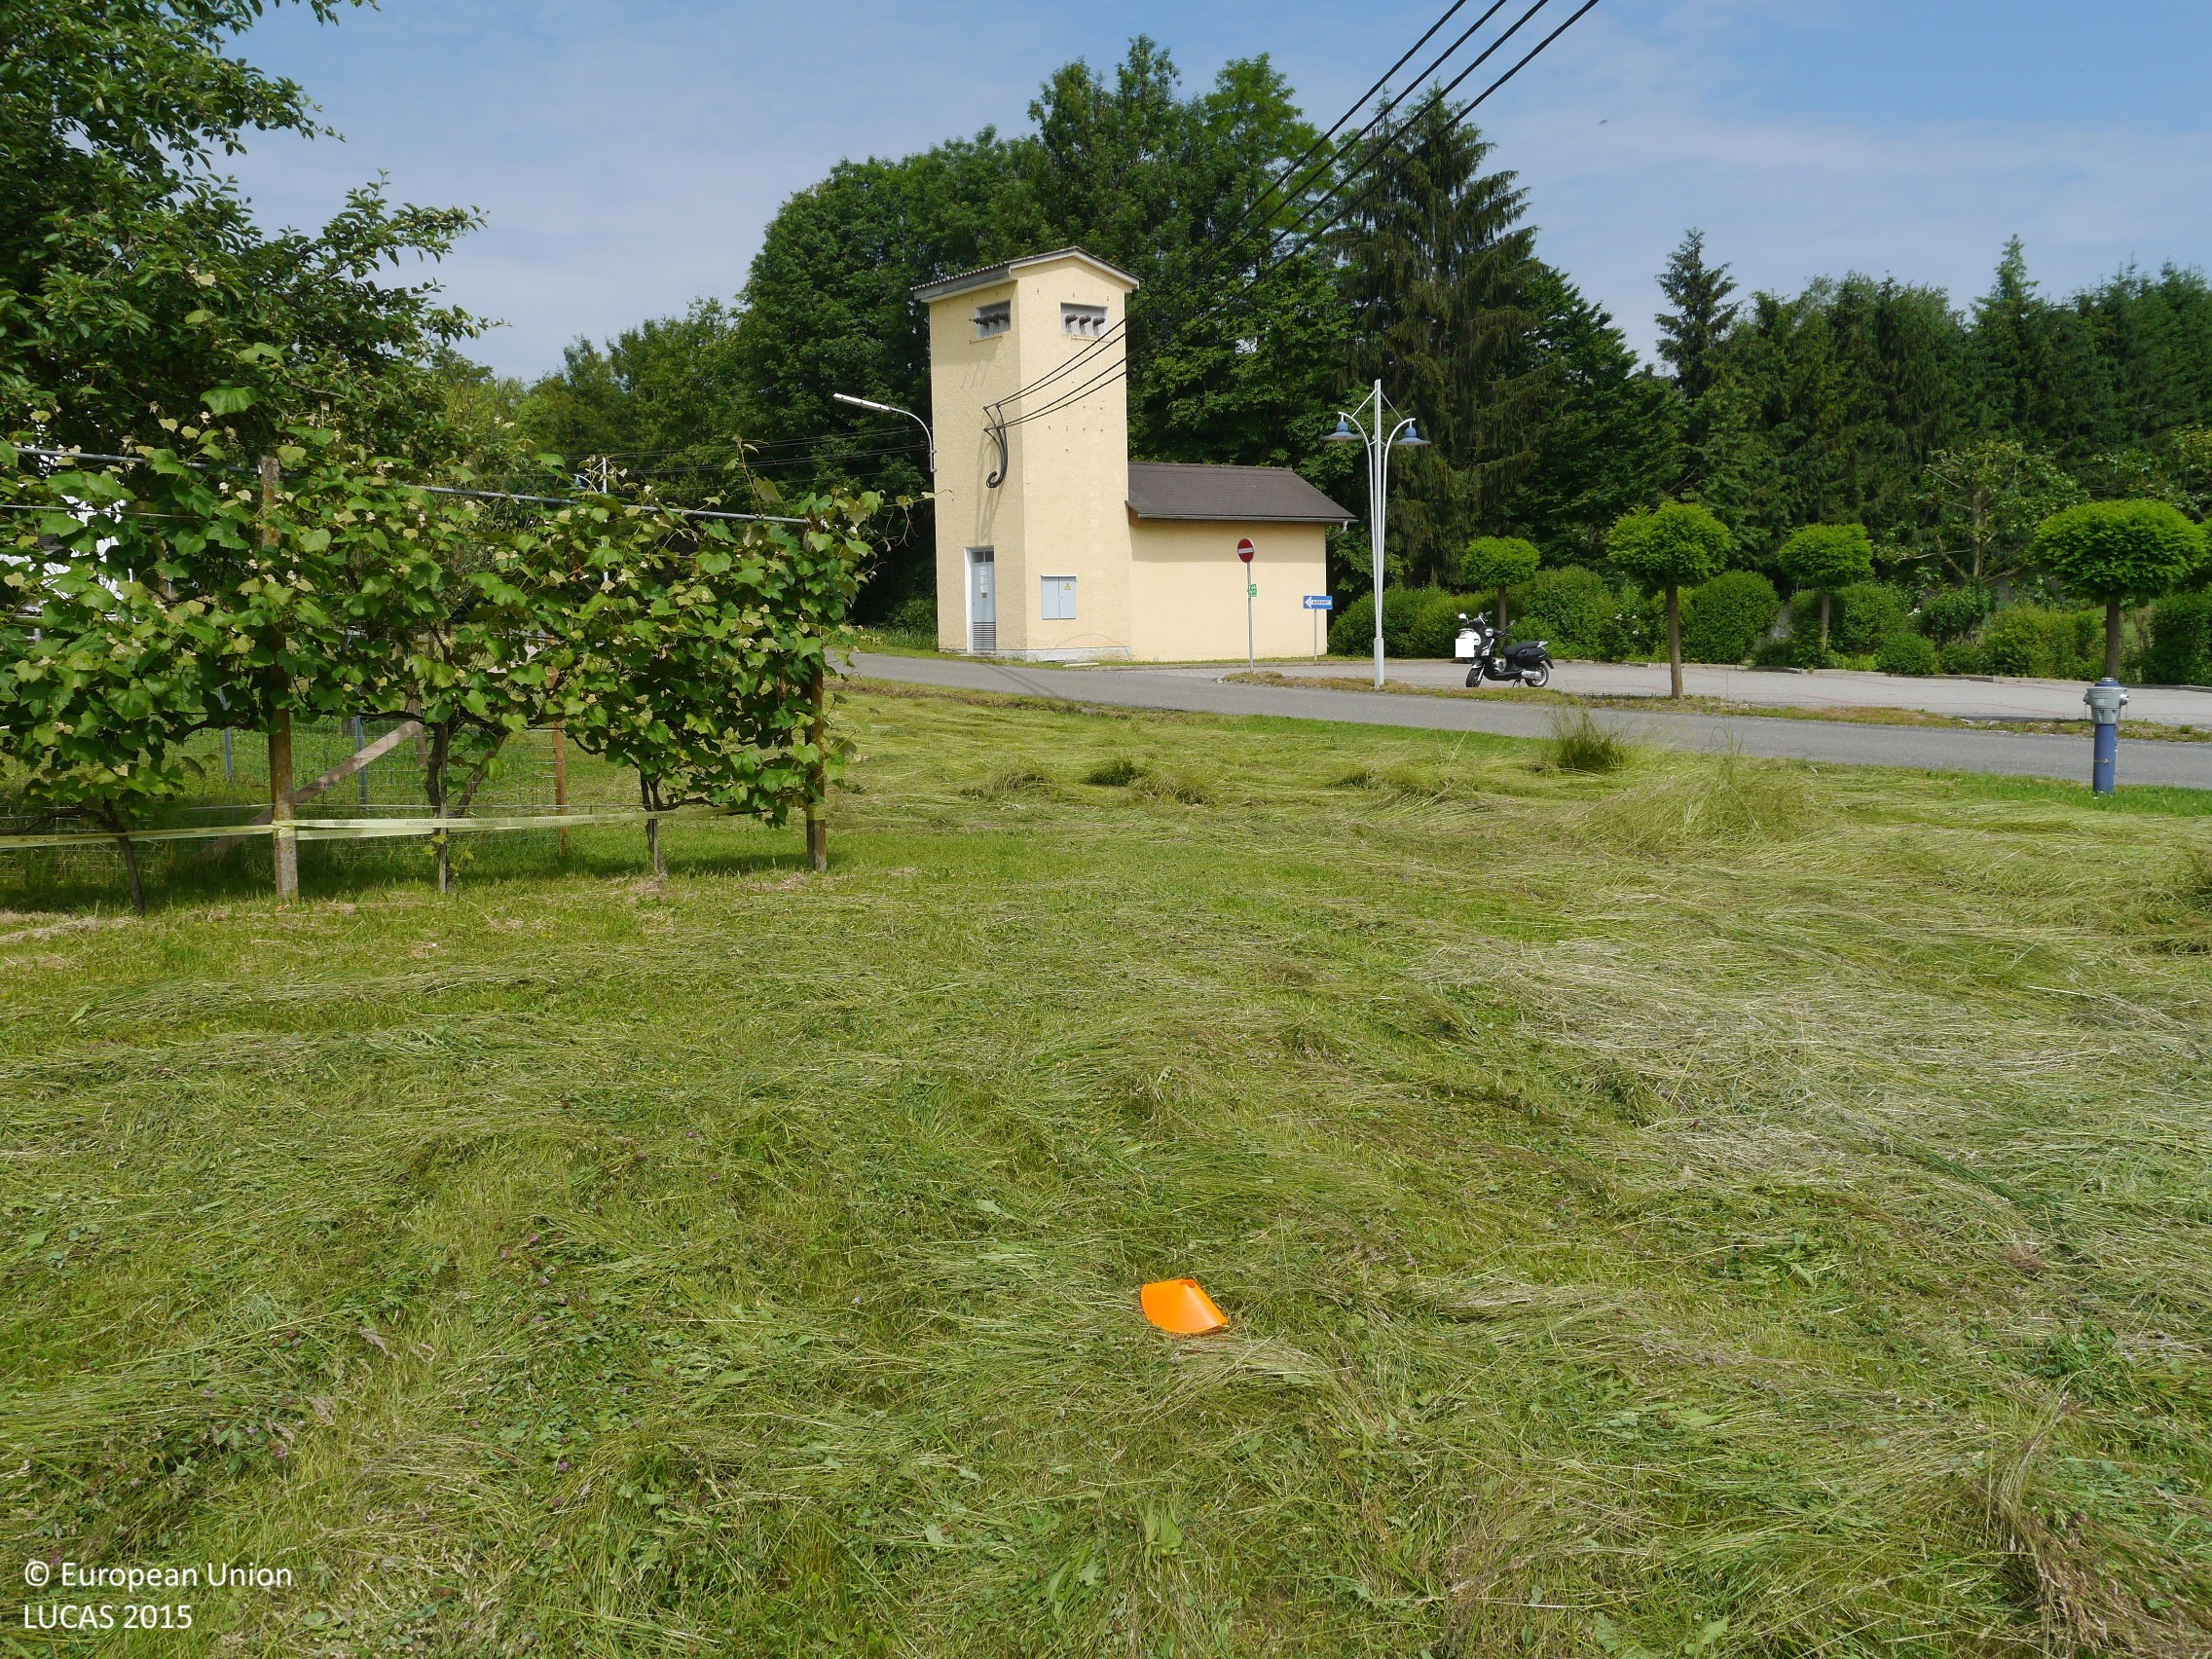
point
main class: Grassland
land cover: Grassland without tree/shrub cover
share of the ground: > 75 %
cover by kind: herbaceous plants 100 %
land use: Agriculture (excluding fallow land and kitchen gardens)
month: June
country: AT
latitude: 46.9027
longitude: 15.7105
